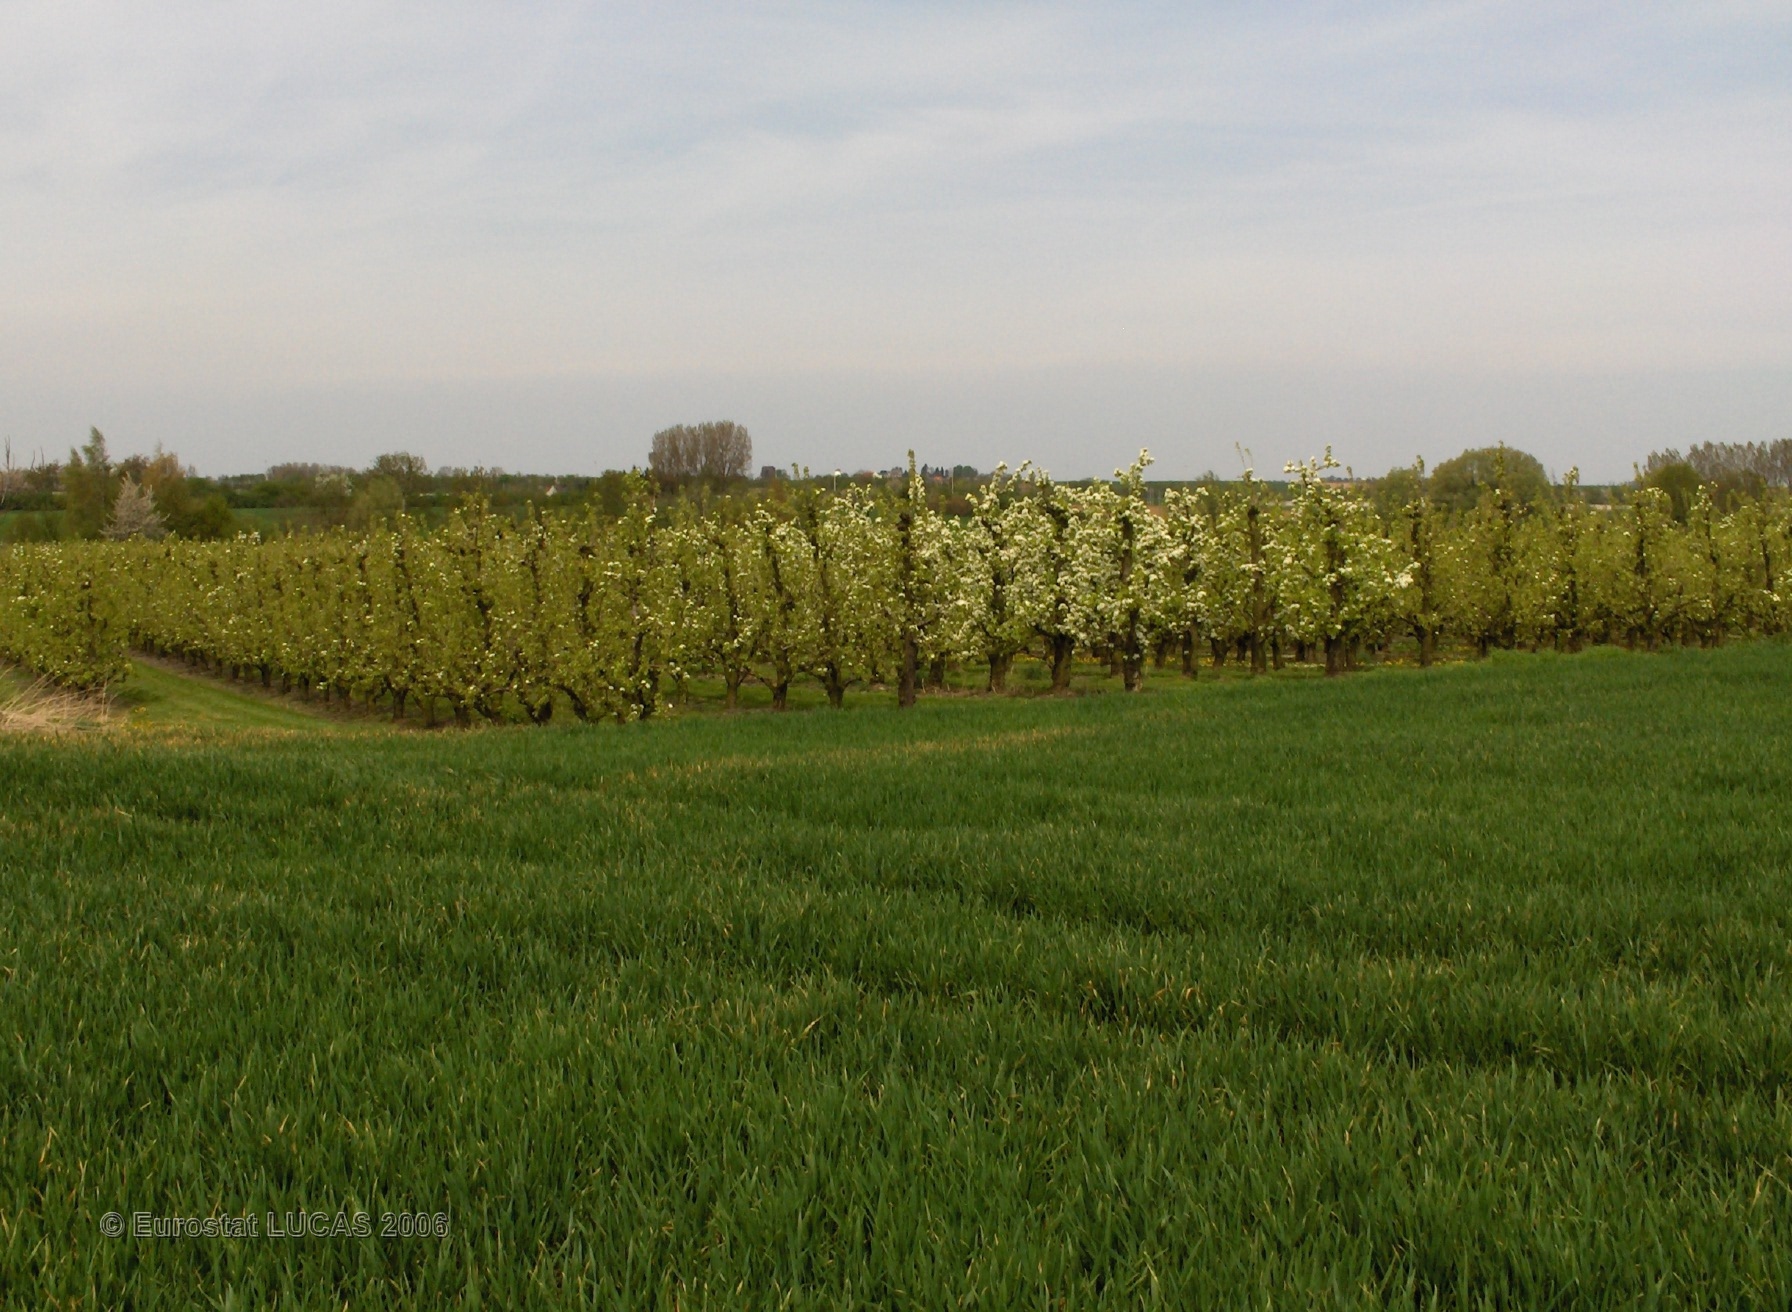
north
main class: Cropland
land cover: Common wheat
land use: Agriculture (excluding fallow land and kitchen gardens)
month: May
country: BE
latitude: 50.6968
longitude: 5.2266
